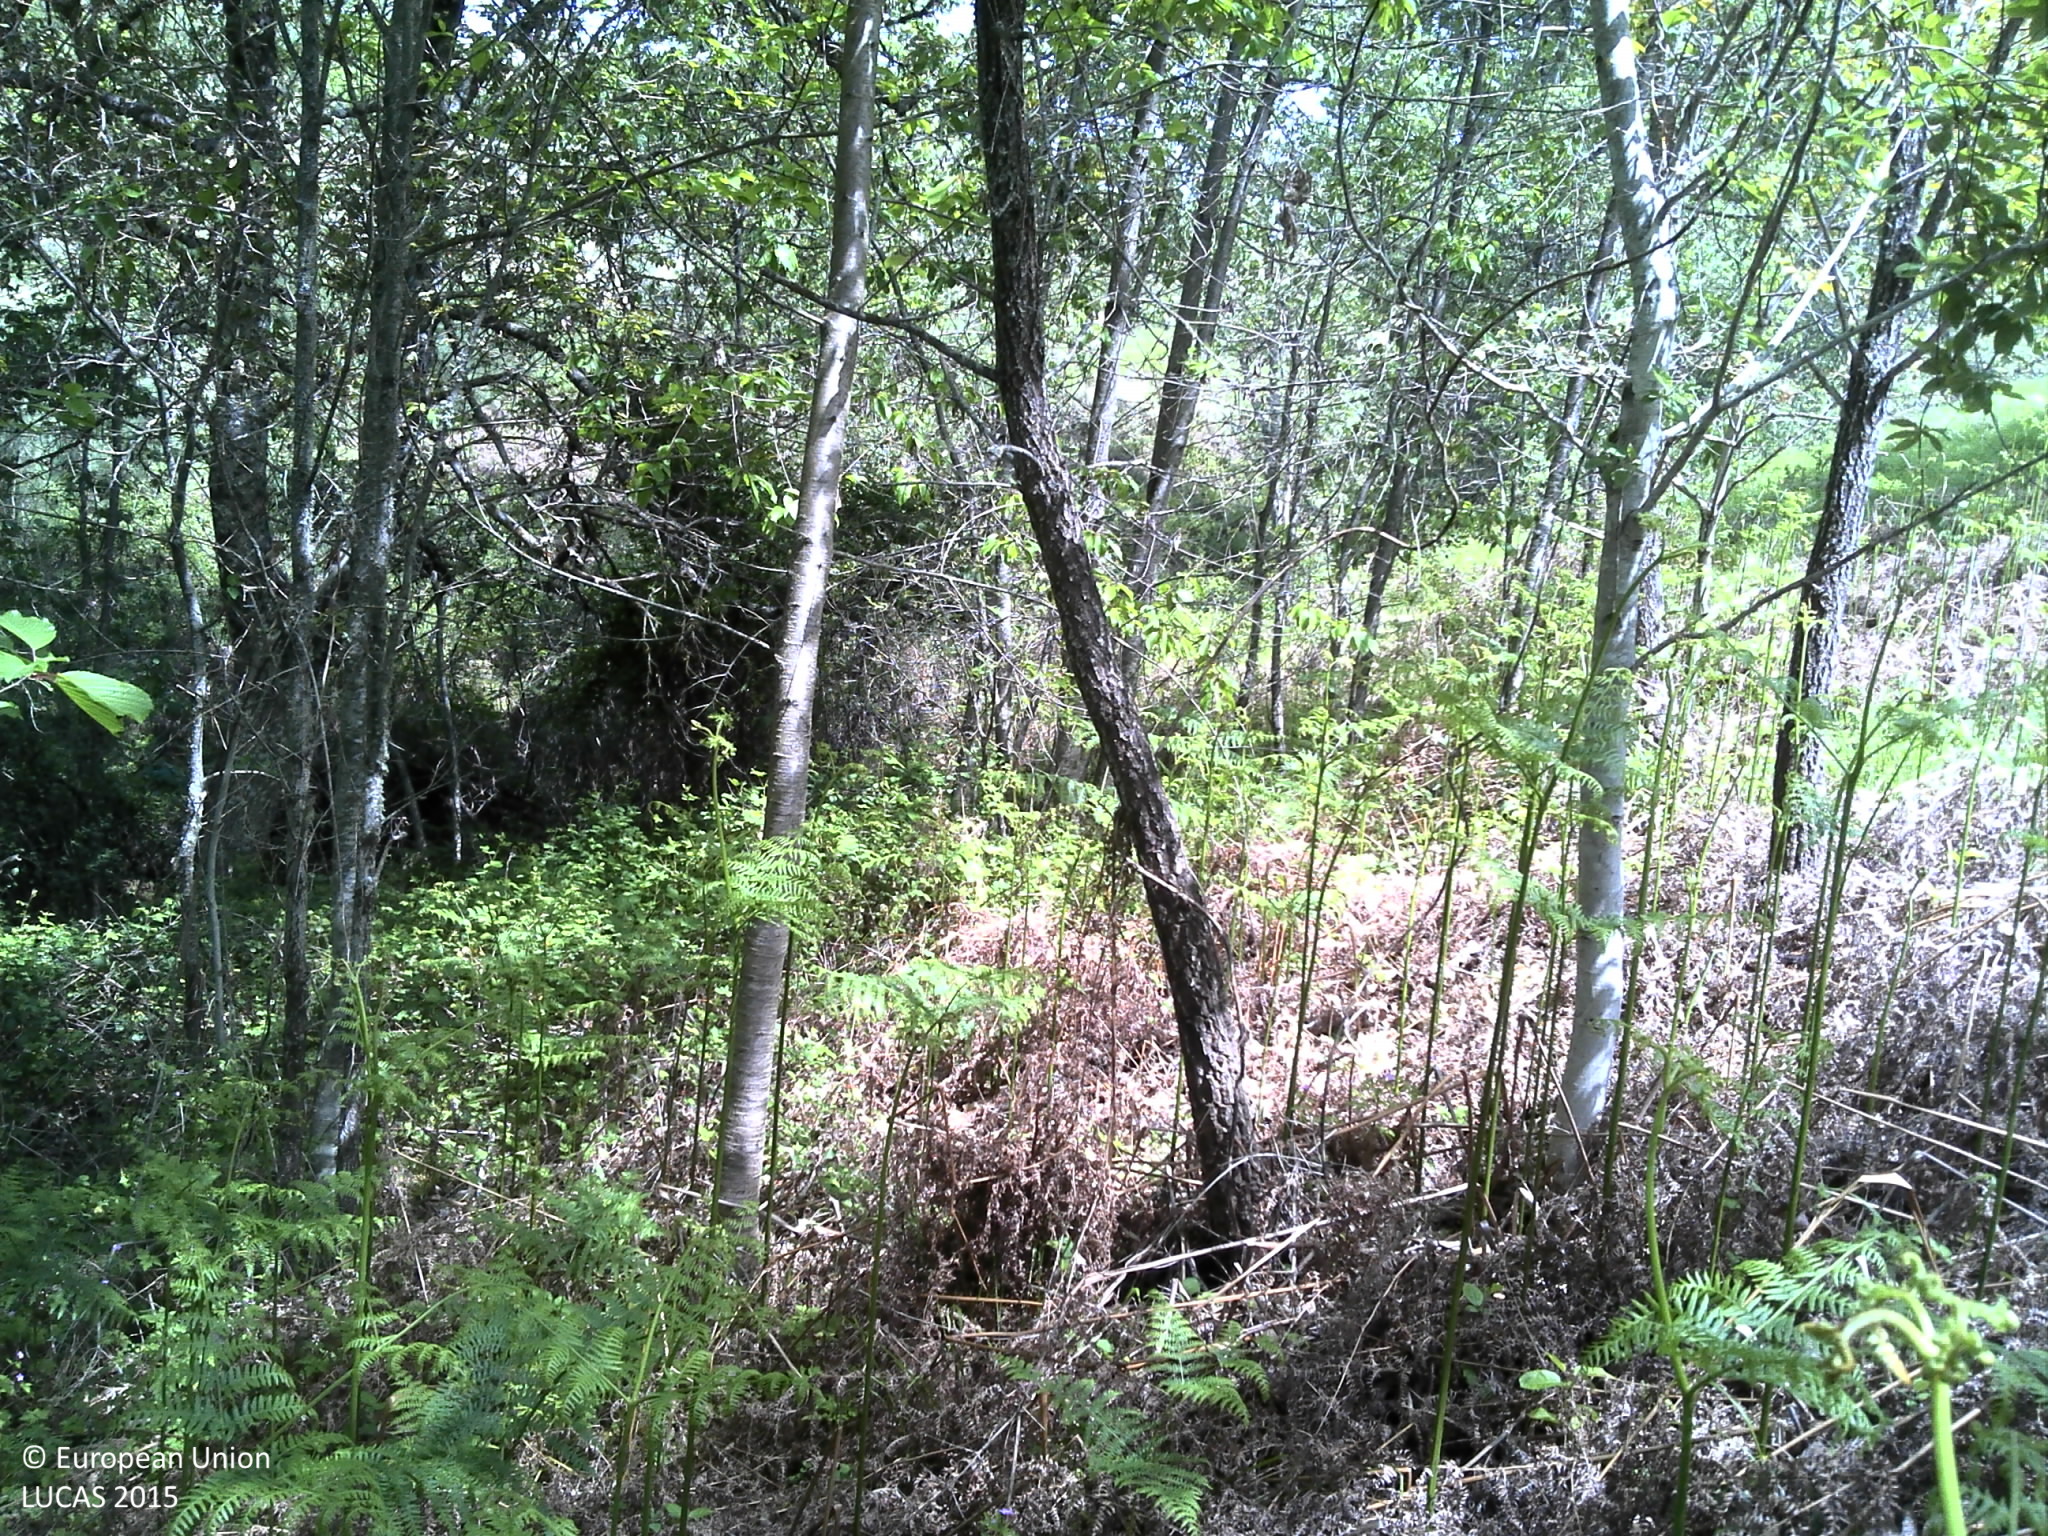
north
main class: Woodland
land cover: Broadleaved woodland
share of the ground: 25 - 50 %
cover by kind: broadleaved forest trees 50 %, unconsolidated bare surface 30 %, shrubs 10 %, herbaceous plants 10 %
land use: Forestry
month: May
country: PT
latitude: 41.8811
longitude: -7.0276
